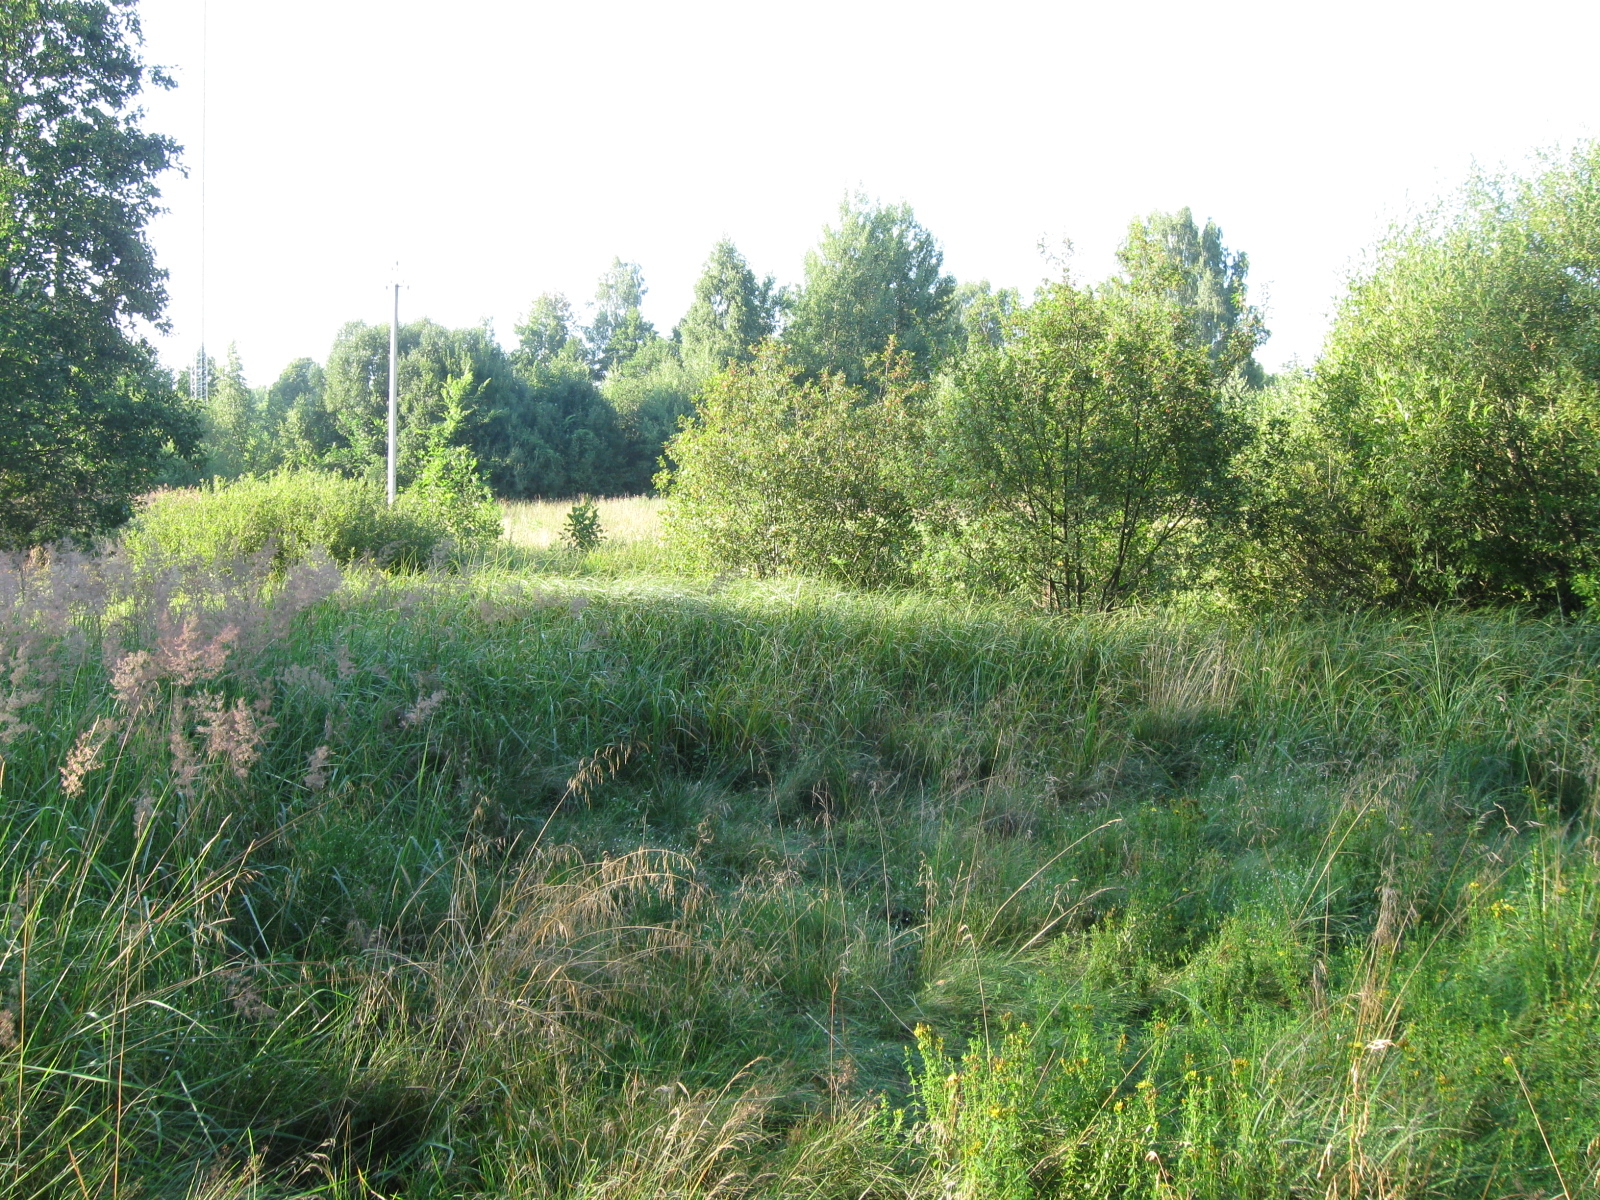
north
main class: Grassland
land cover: Grassland with sparse tree/shrub cover
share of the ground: > 75 %
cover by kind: herbaceous plants 75 %, lichens and mosses 15 %, broadleaved forest trees 5 %, shrubs 5 %
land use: Semi-natural and natural areas not in use
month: August
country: LT
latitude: 54.8184
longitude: 23.4485
